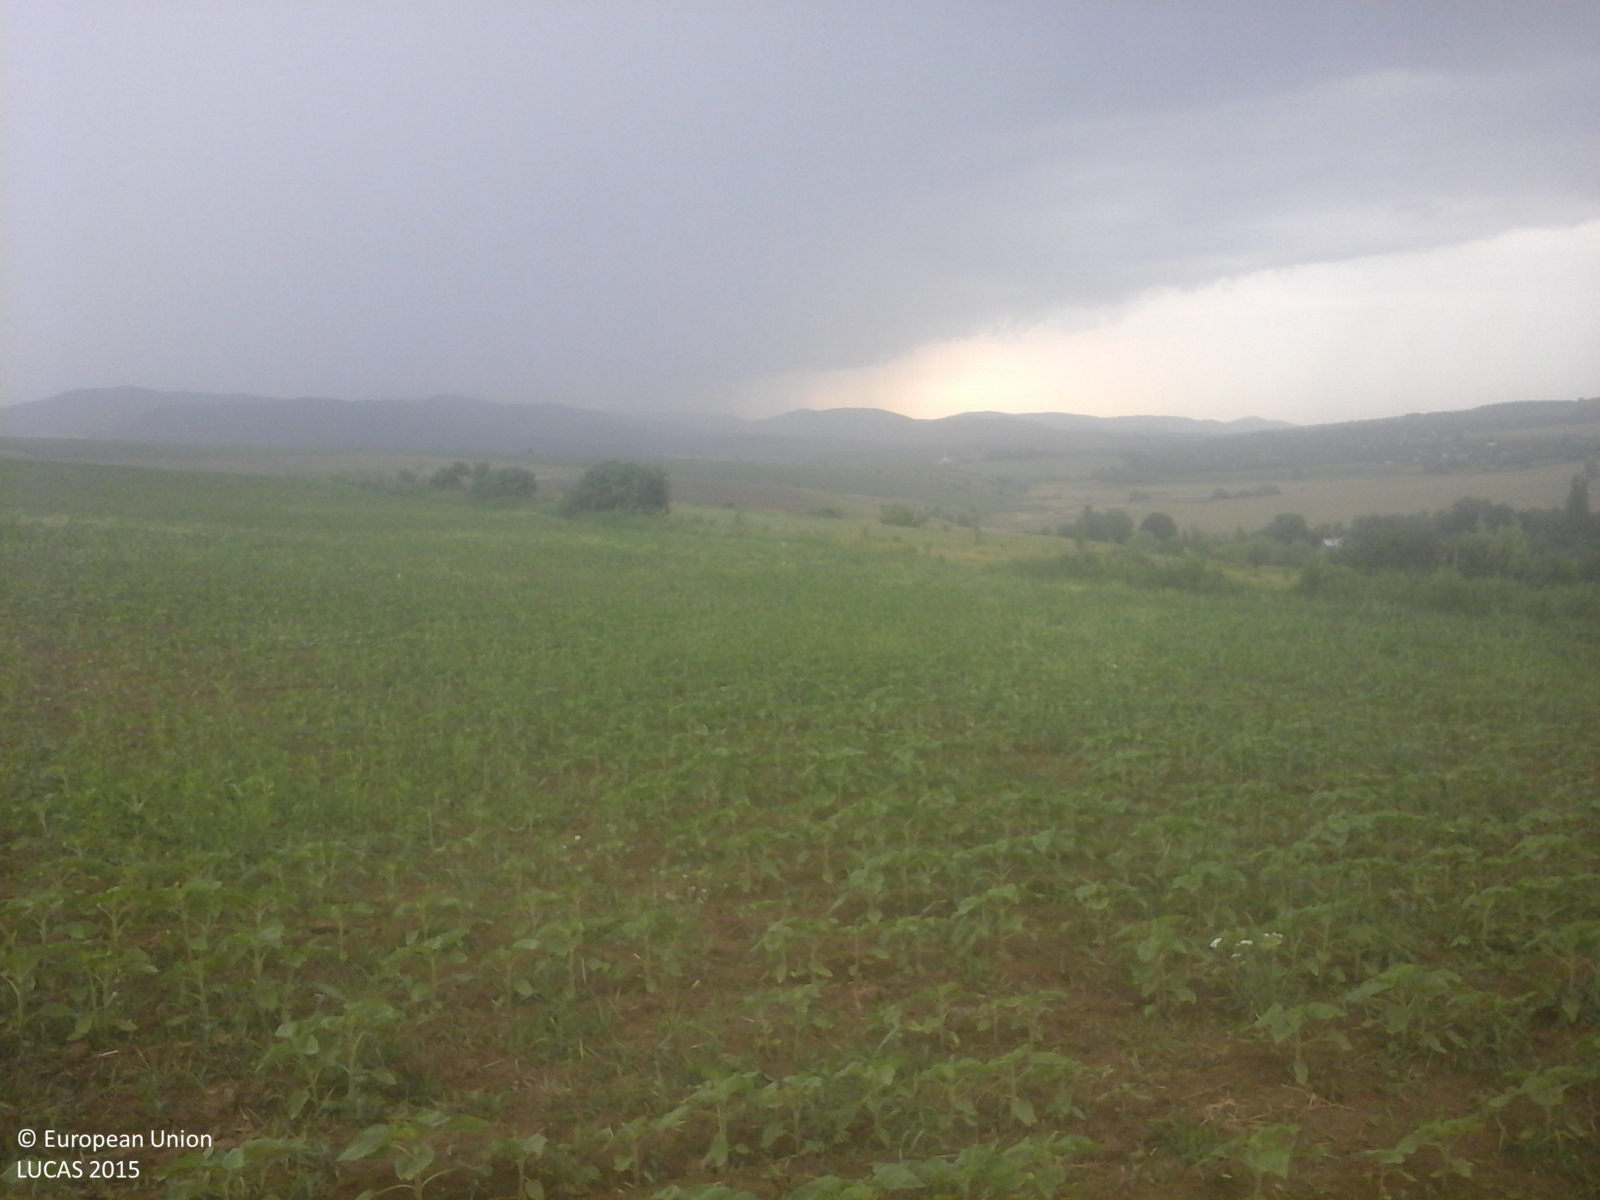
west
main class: Cropland
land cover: Sunflower
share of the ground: 25 - 50 %
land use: Agriculture (excluding fallow land and kitchen gardens)
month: June
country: RO
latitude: 47.0019
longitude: 26.4041
